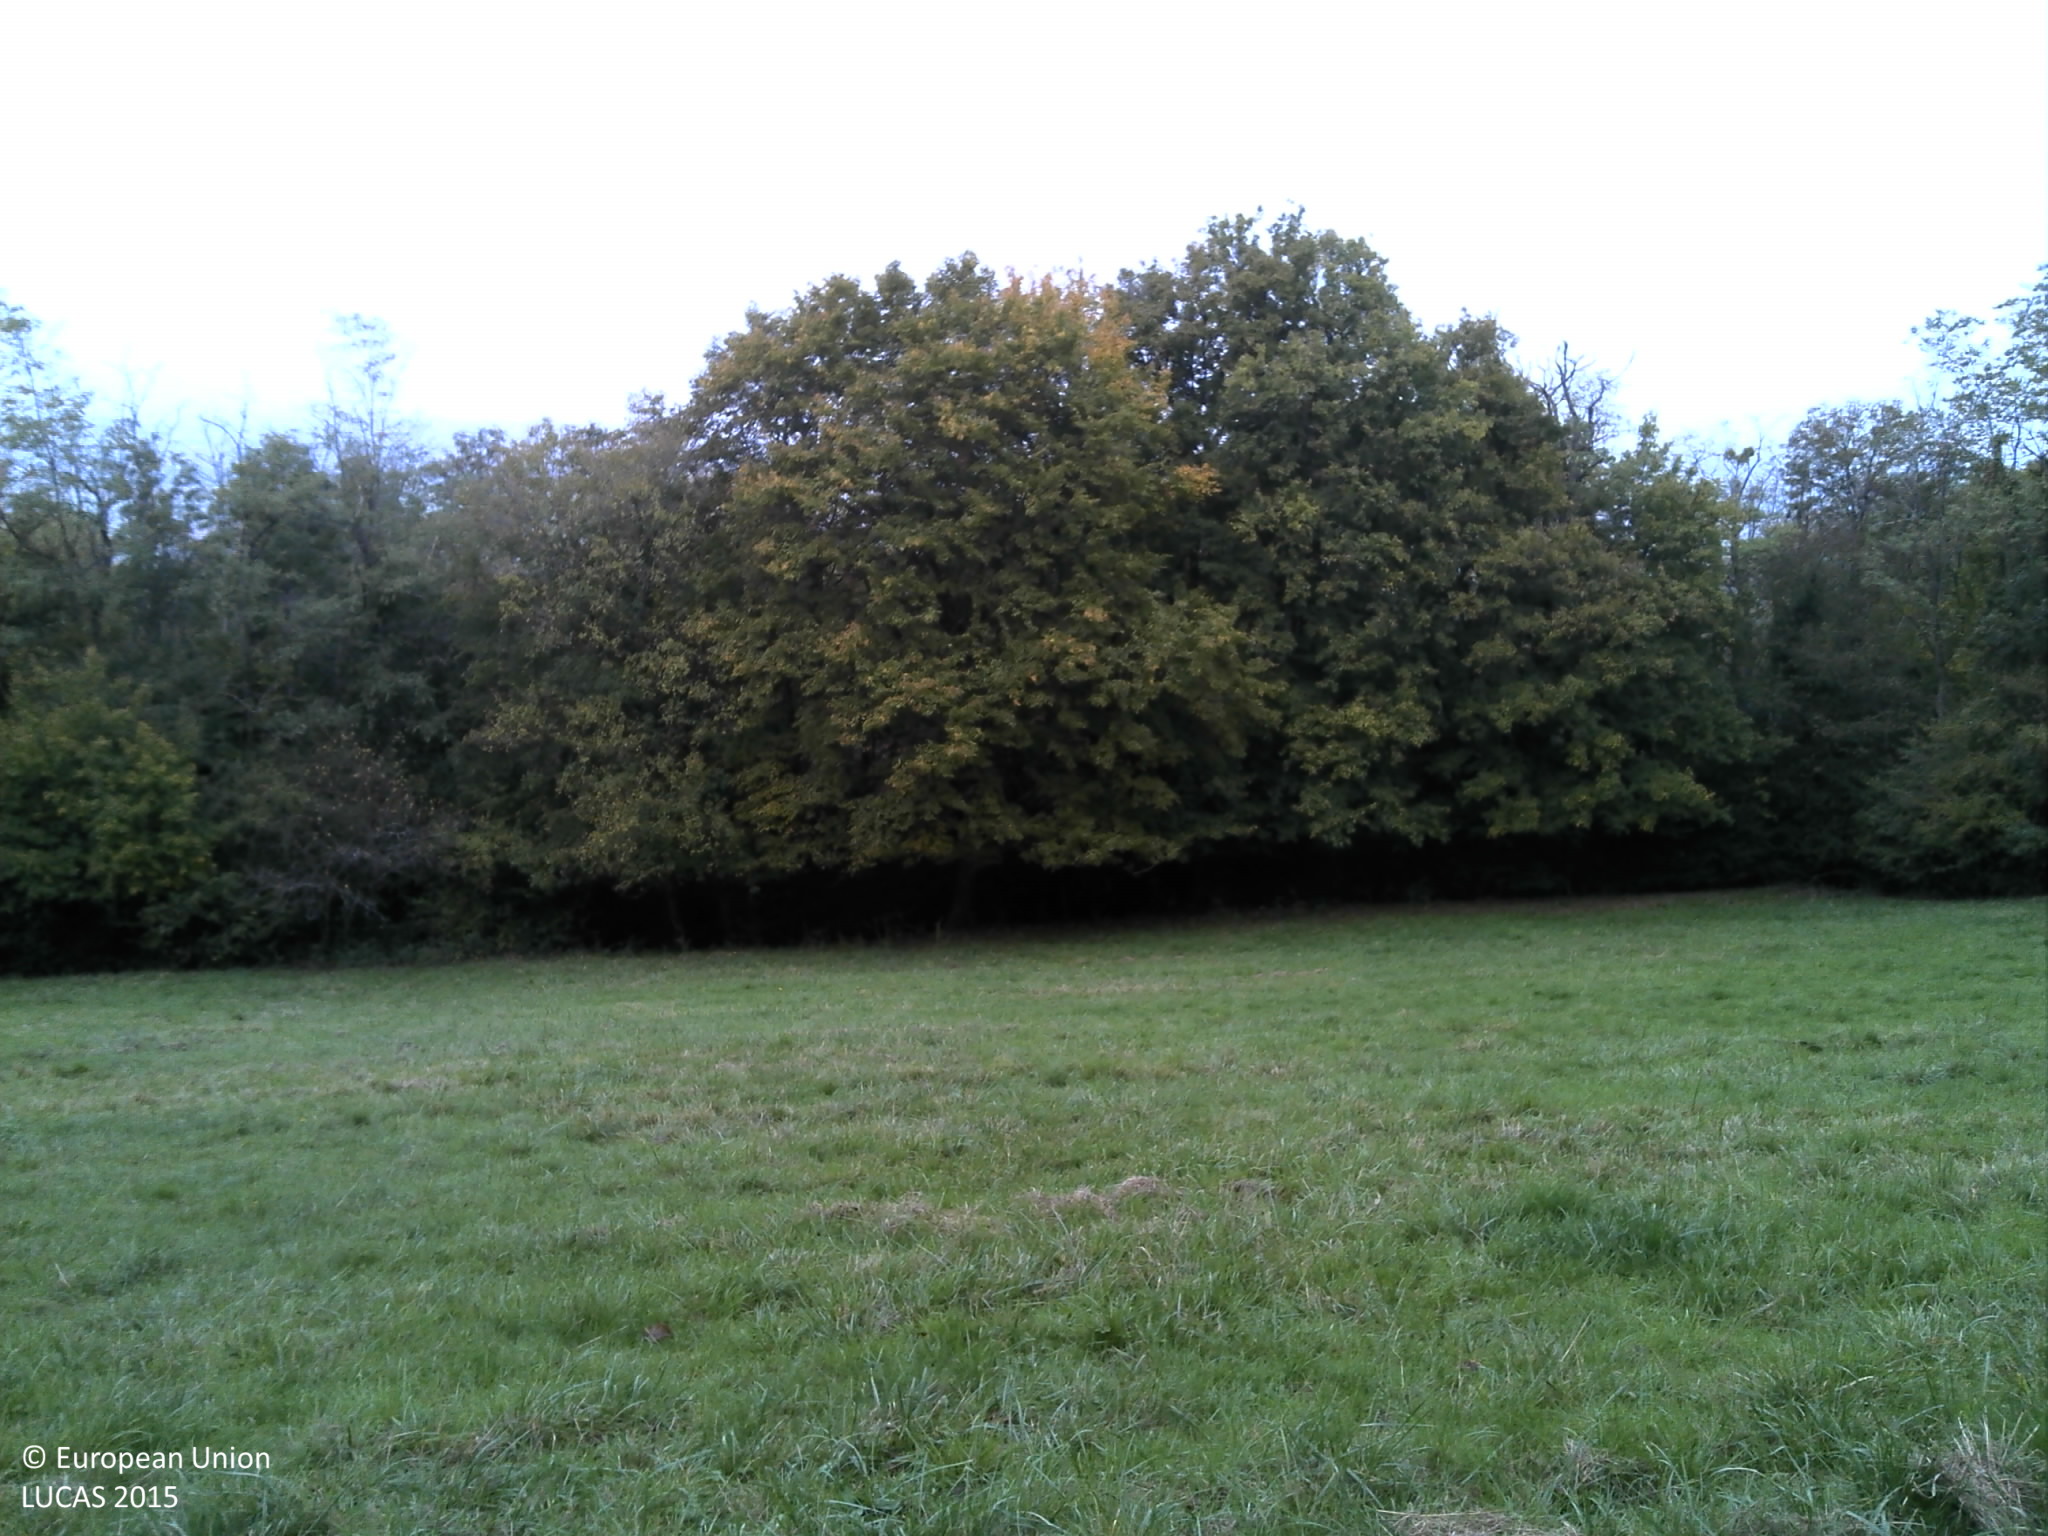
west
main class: Grassland
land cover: Grassland with sparse tree/shrub cover
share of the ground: > 75 %
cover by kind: herbaceous plants 95 %, broadleaved forest trees 5 %
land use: Agriculture (excluding fallow land and kitchen gardens)
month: October
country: FR
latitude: 46.1050
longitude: 5.3330
